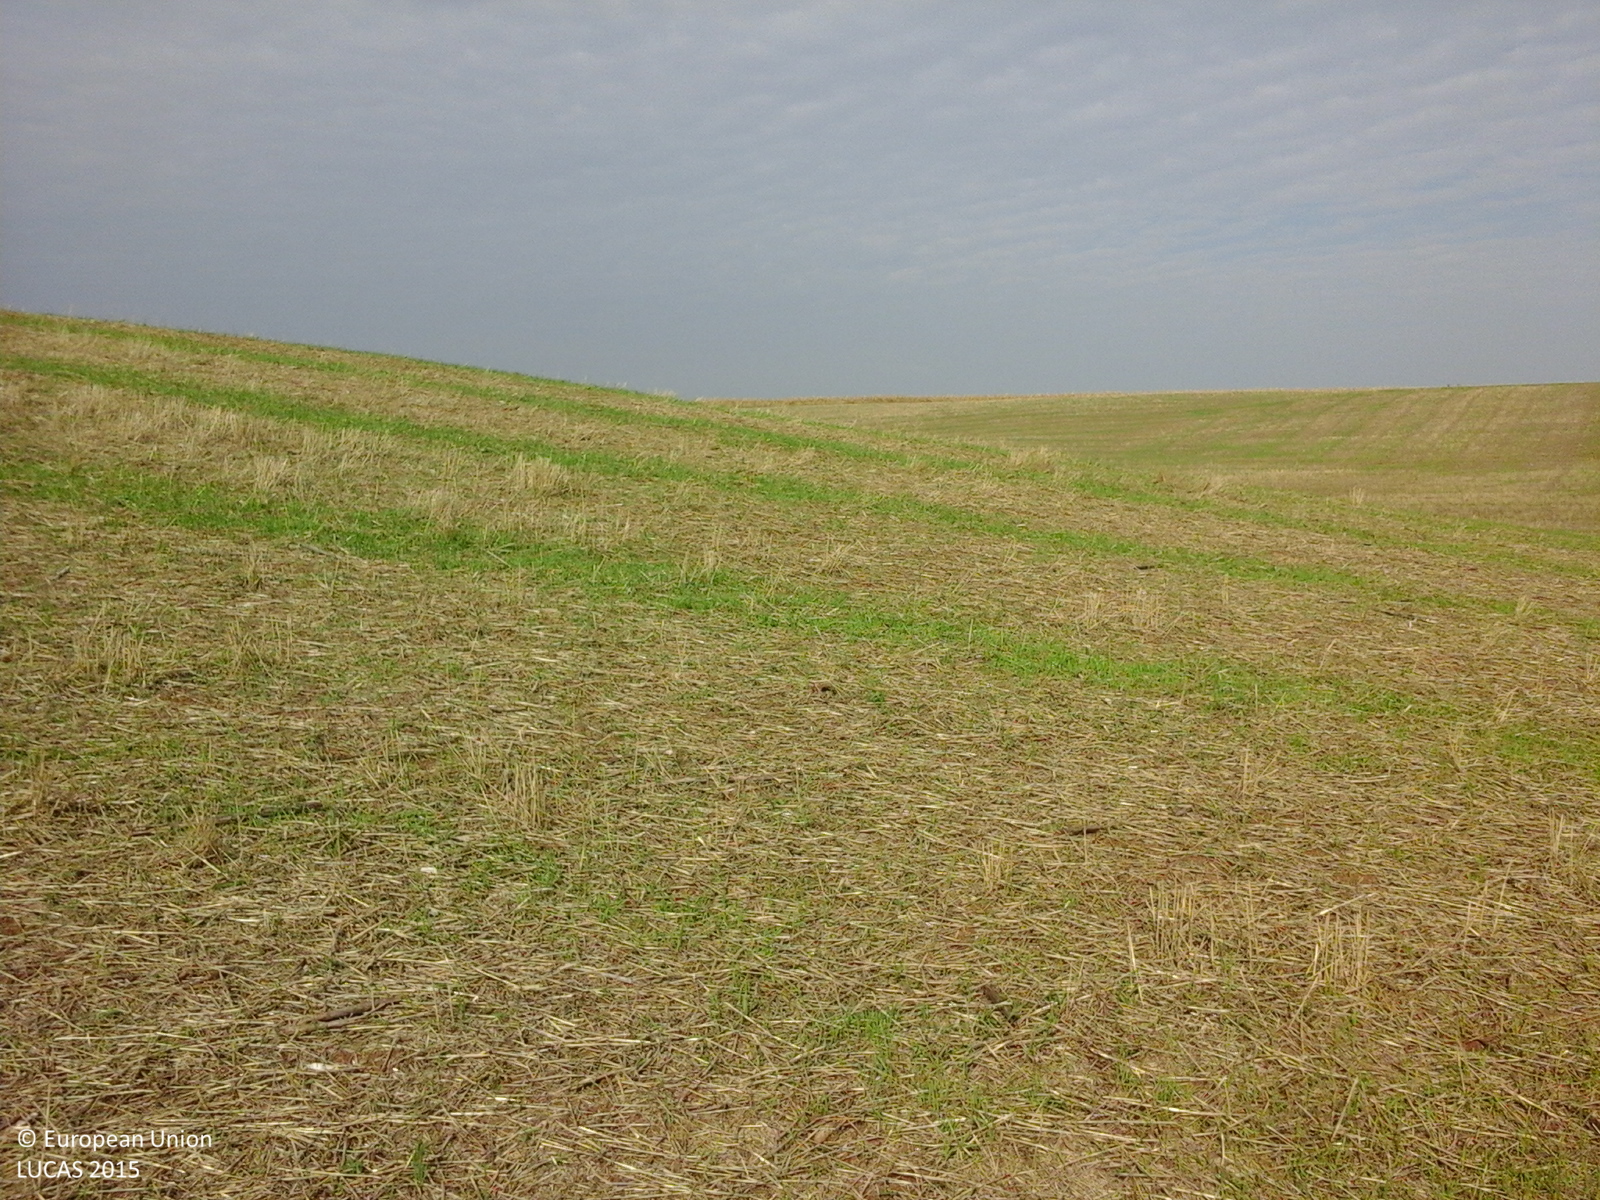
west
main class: Cropland
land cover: Common wheat
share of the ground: 50 - 75 %
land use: Agriculture (excluding fallow land and kitchen gardens)
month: August
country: RO
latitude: 46.0916
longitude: 21.5080
